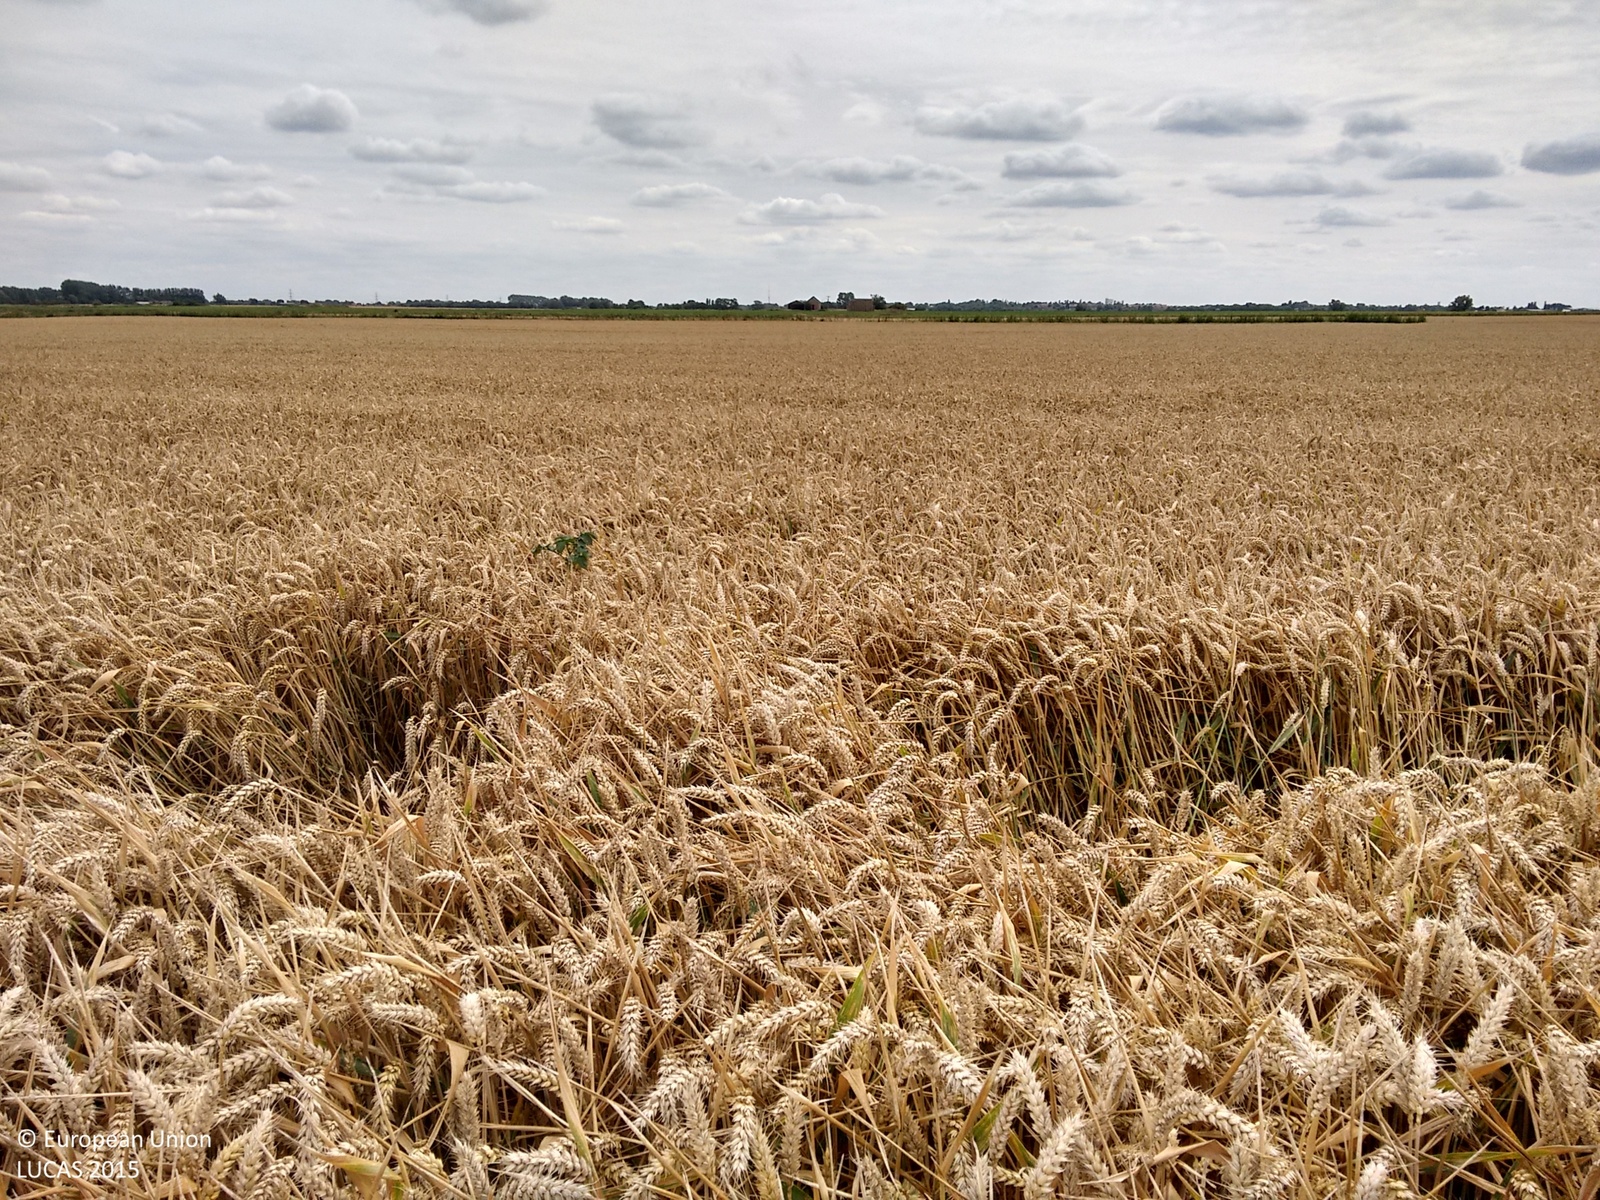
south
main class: Cropland
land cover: Common wheat
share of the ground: > 75 %
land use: Agriculture (excluding fallow land and kitchen gardens)
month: August
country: GB
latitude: 52.4861
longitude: 0.2954
